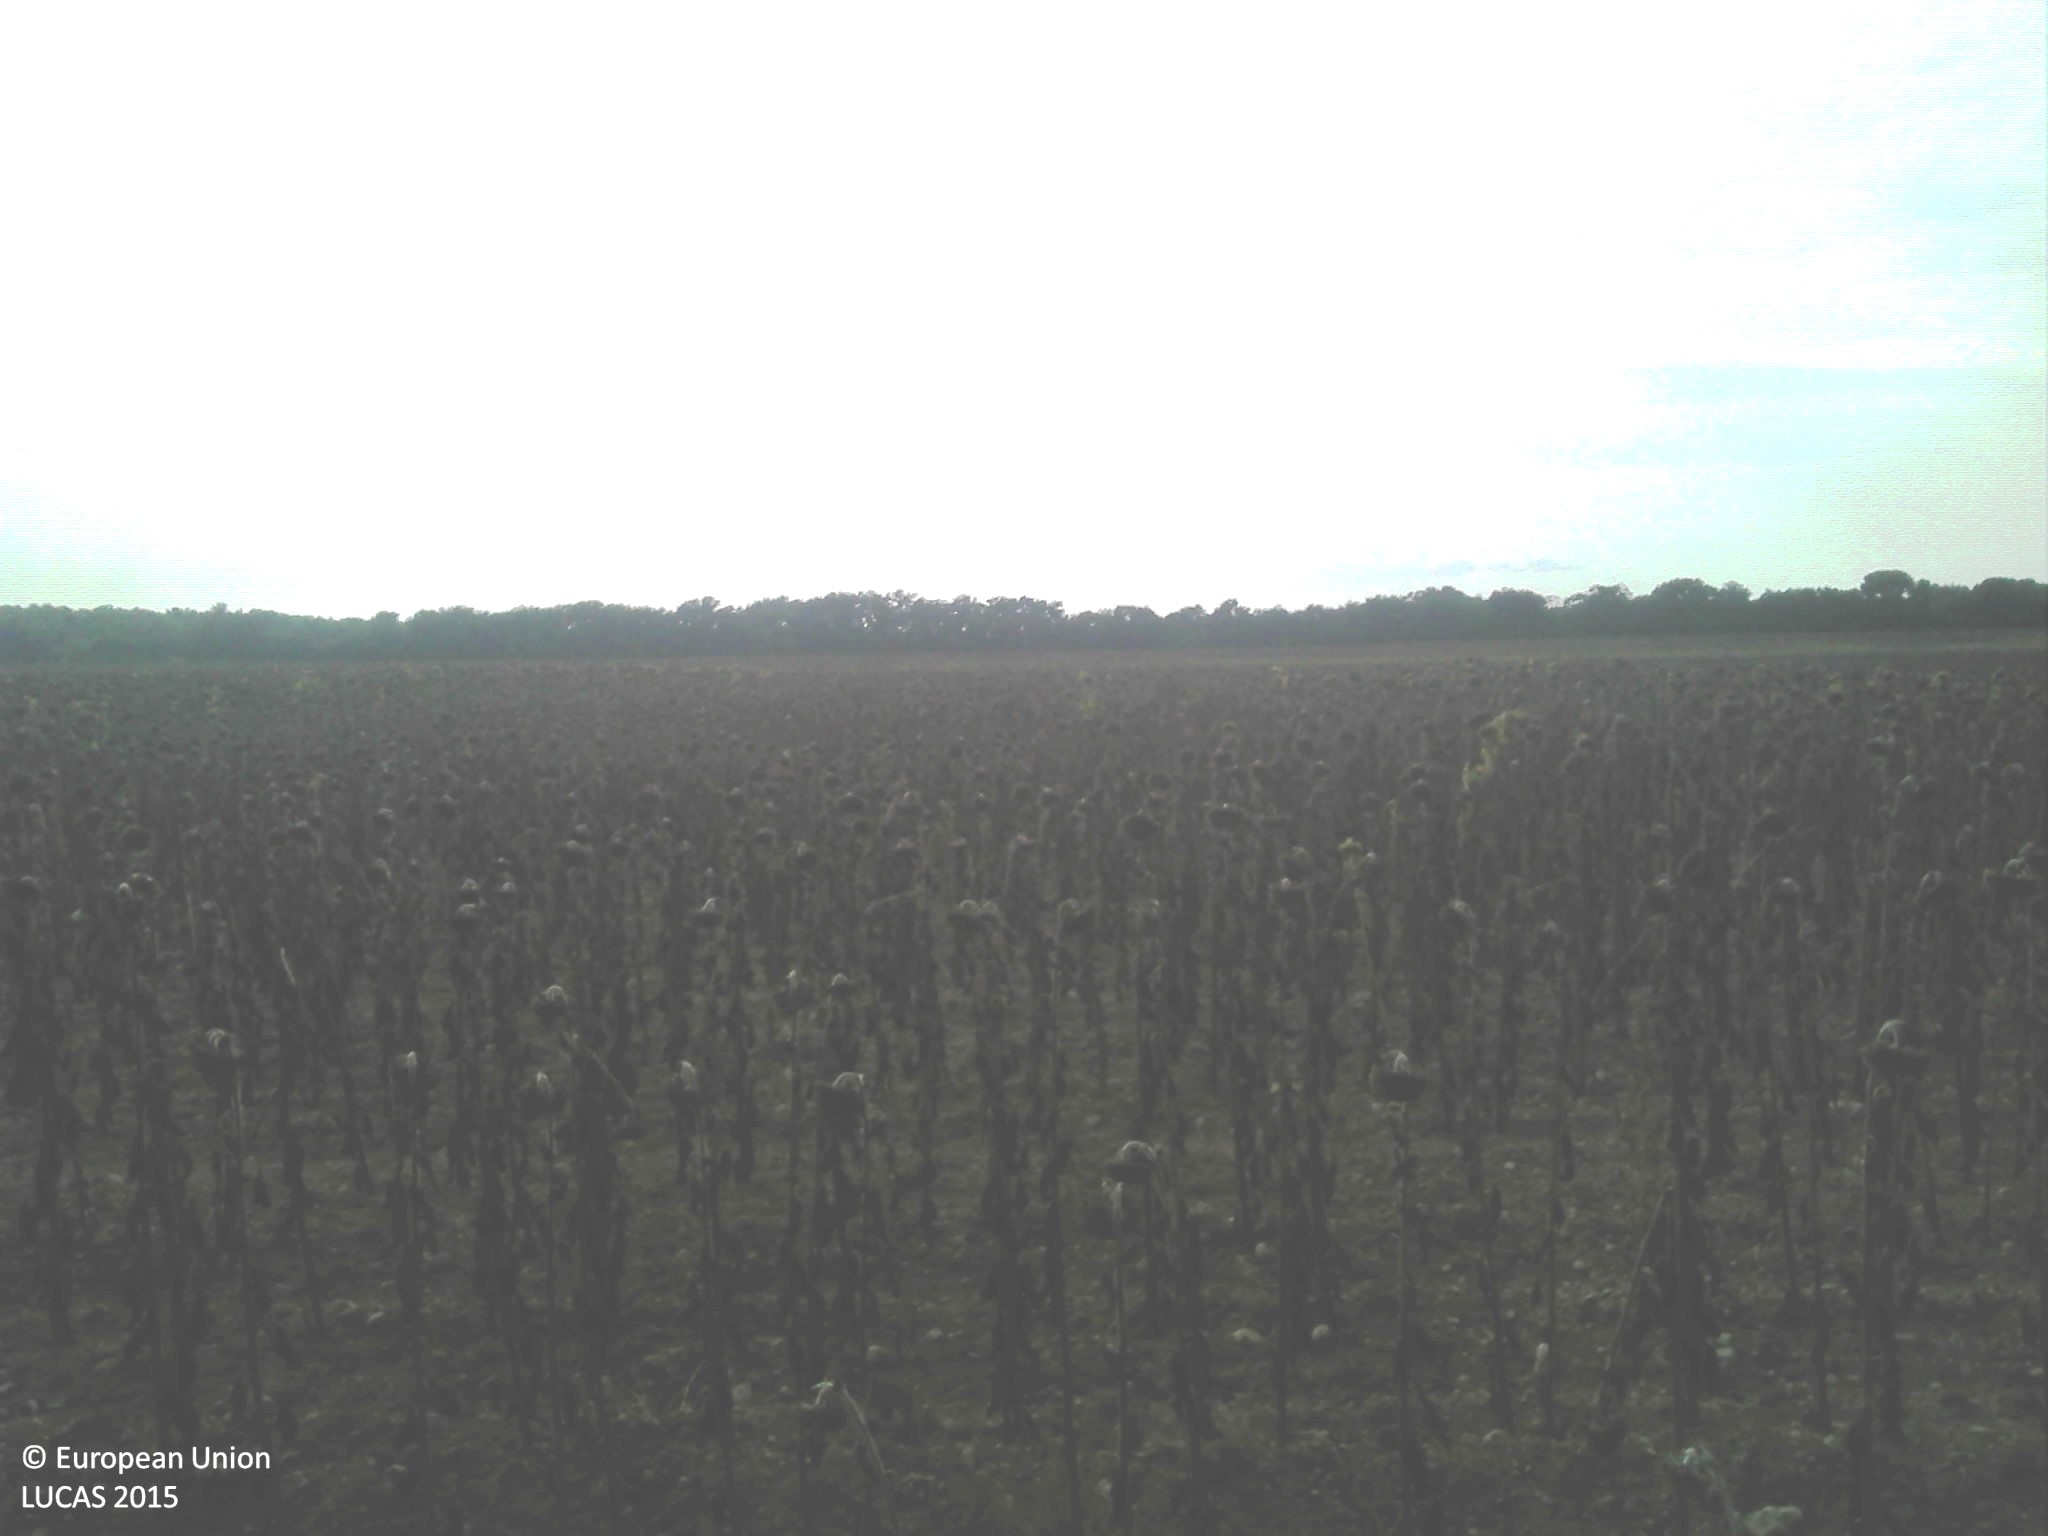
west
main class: Cropland
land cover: Sunflower
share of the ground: 25 - 50 %
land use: Agriculture (excluding fallow land and kitchen gardens)
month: August
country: FR
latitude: 43.5977
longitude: 5.3890
